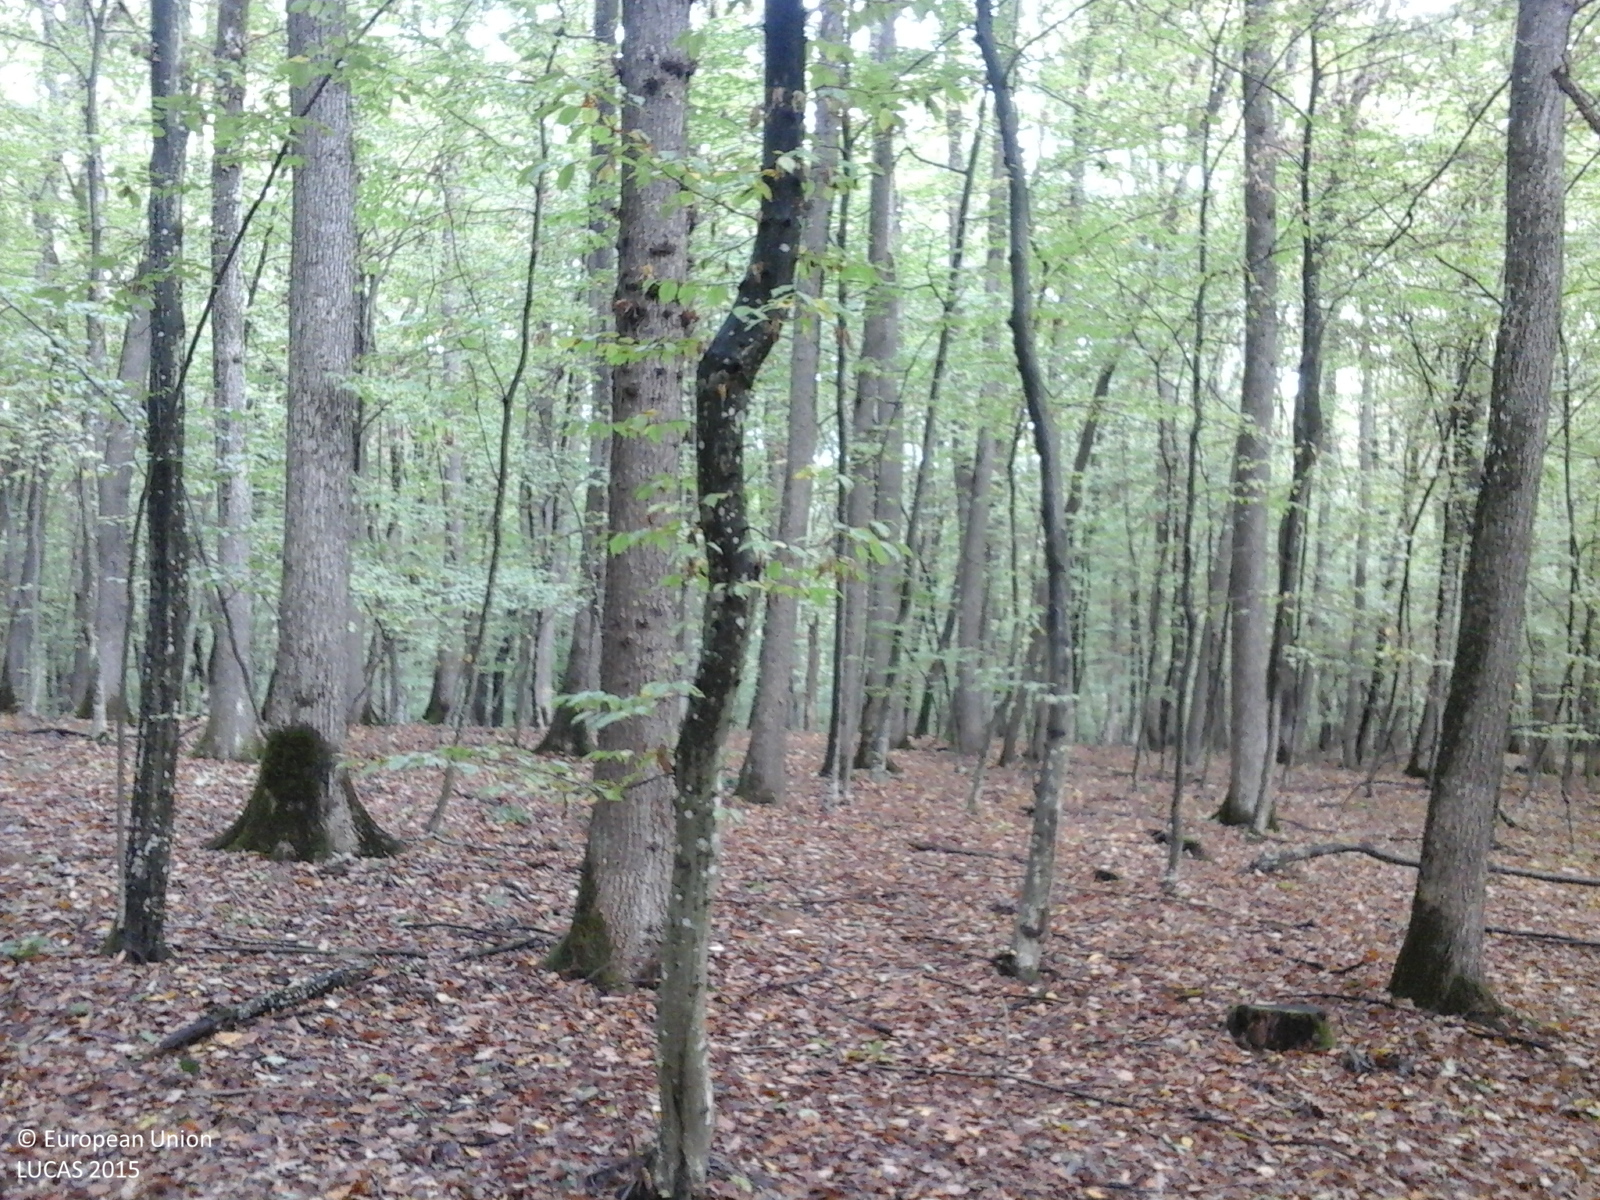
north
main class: Woodland
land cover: Broadleaved woodland
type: beech forest
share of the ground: > 75 %
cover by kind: broadleaved forest trees 100 %
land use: Forestry
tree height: > 5 m
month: October
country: RO
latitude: 45.8798
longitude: 24.6843
